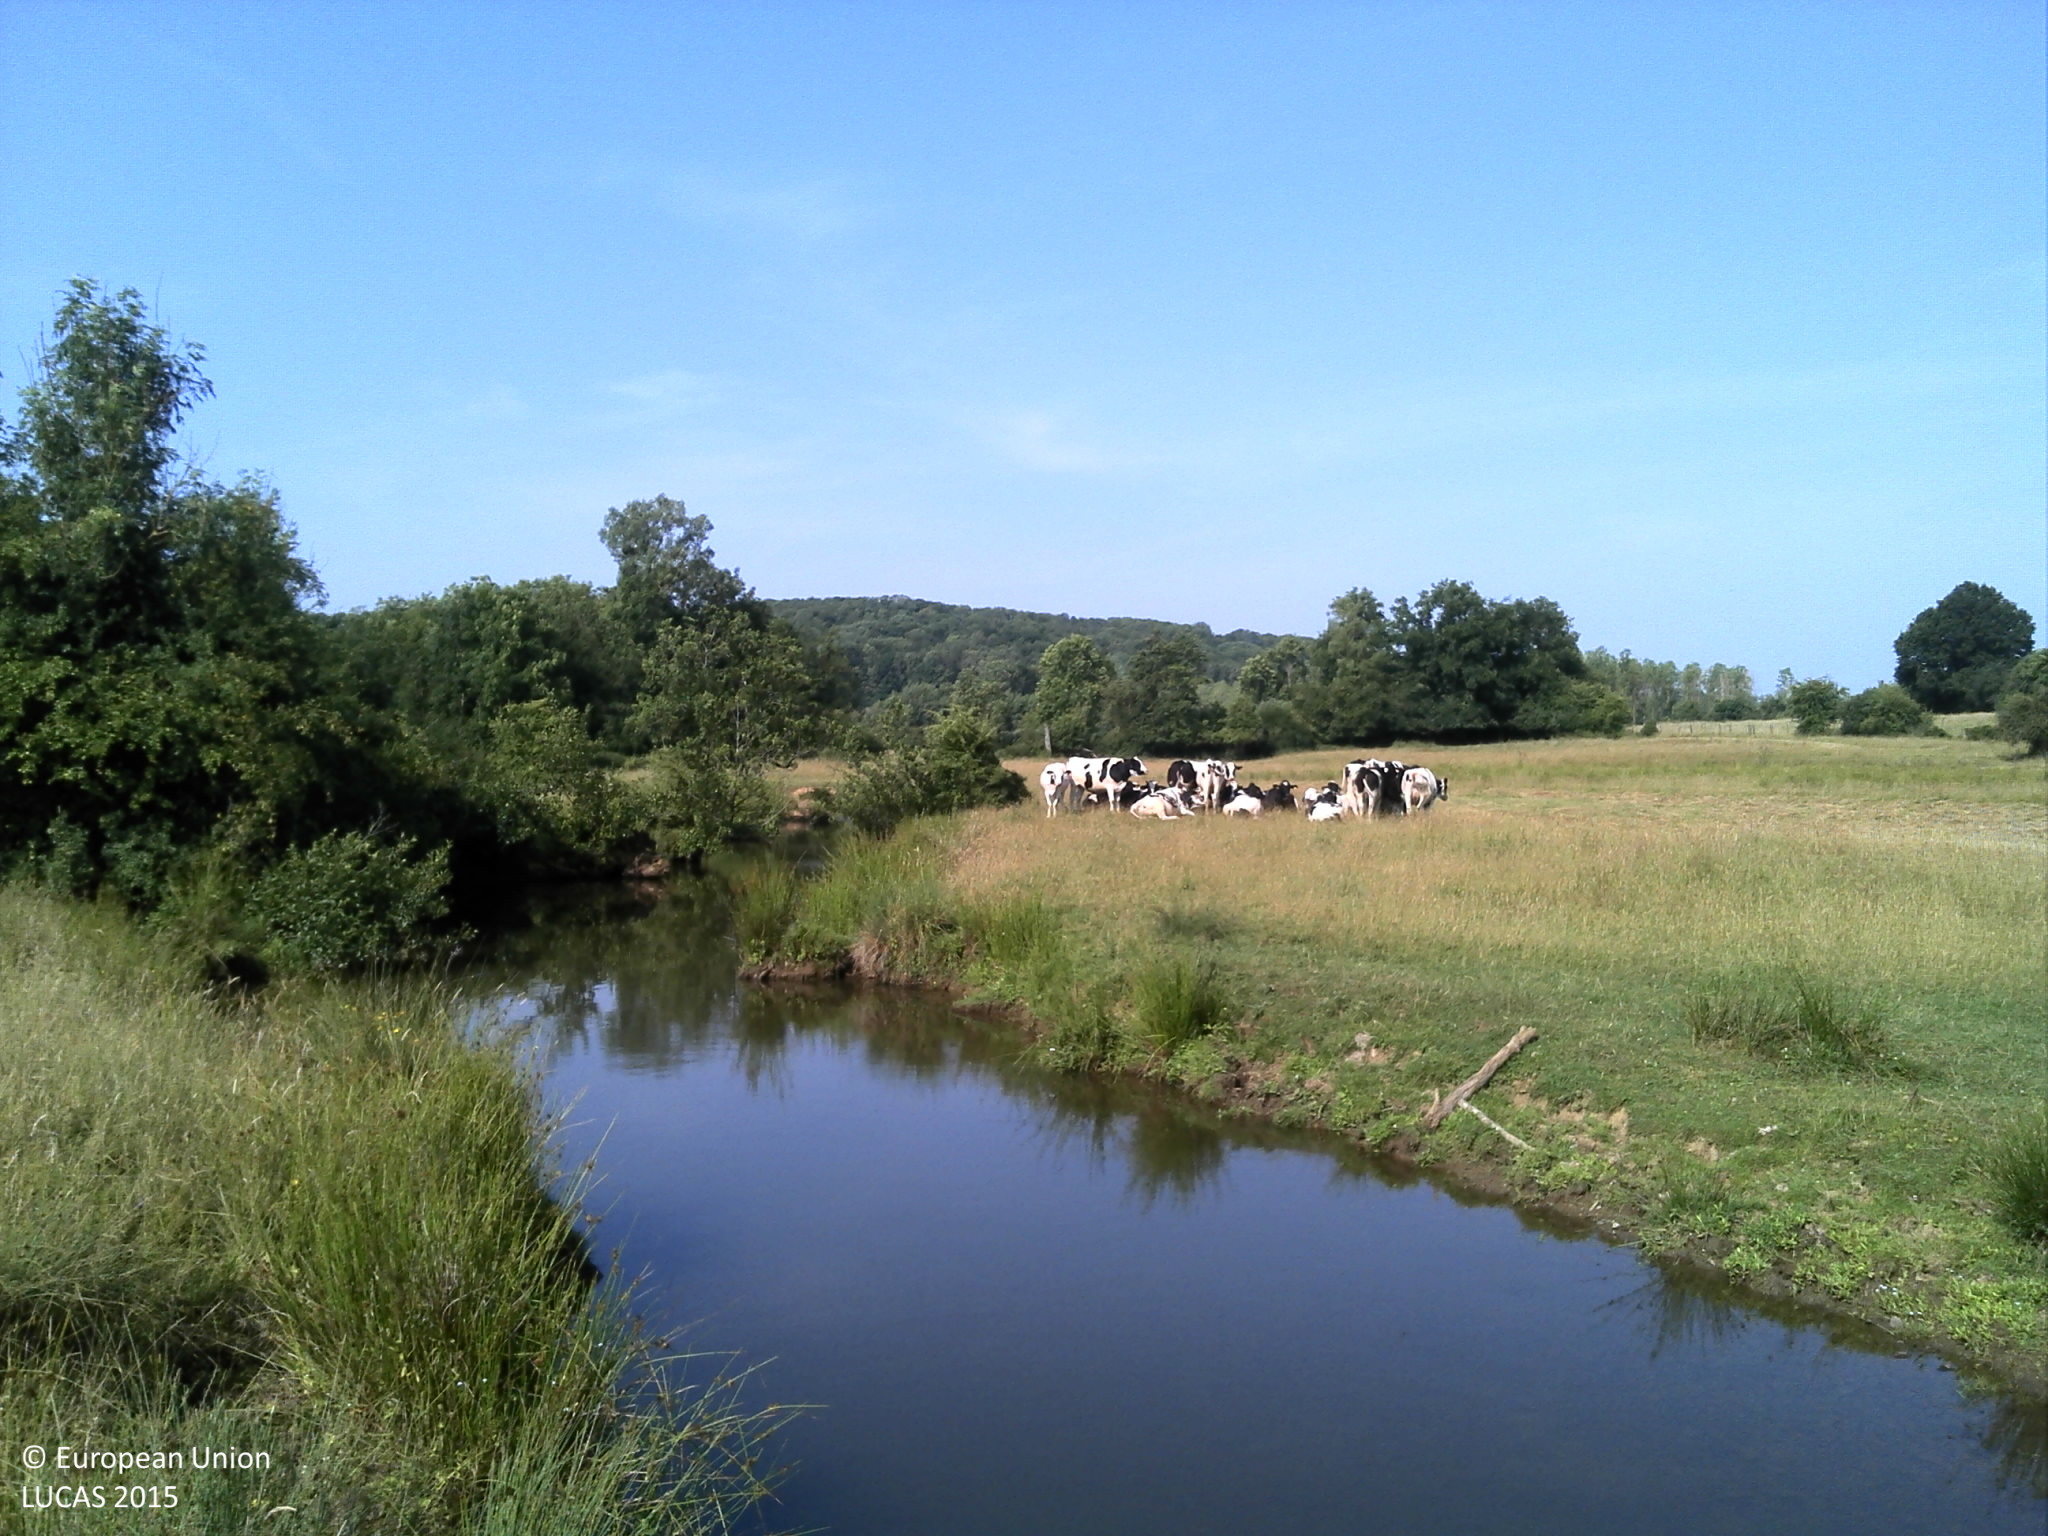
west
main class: Grassland
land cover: Grassland without tree/shrub cover
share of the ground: > 75 %
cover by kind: herbaceous plants 100 %
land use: Agriculture (excluding fallow land and kitchen gardens)
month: July
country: FR
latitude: 49.8341
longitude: 4.4764
